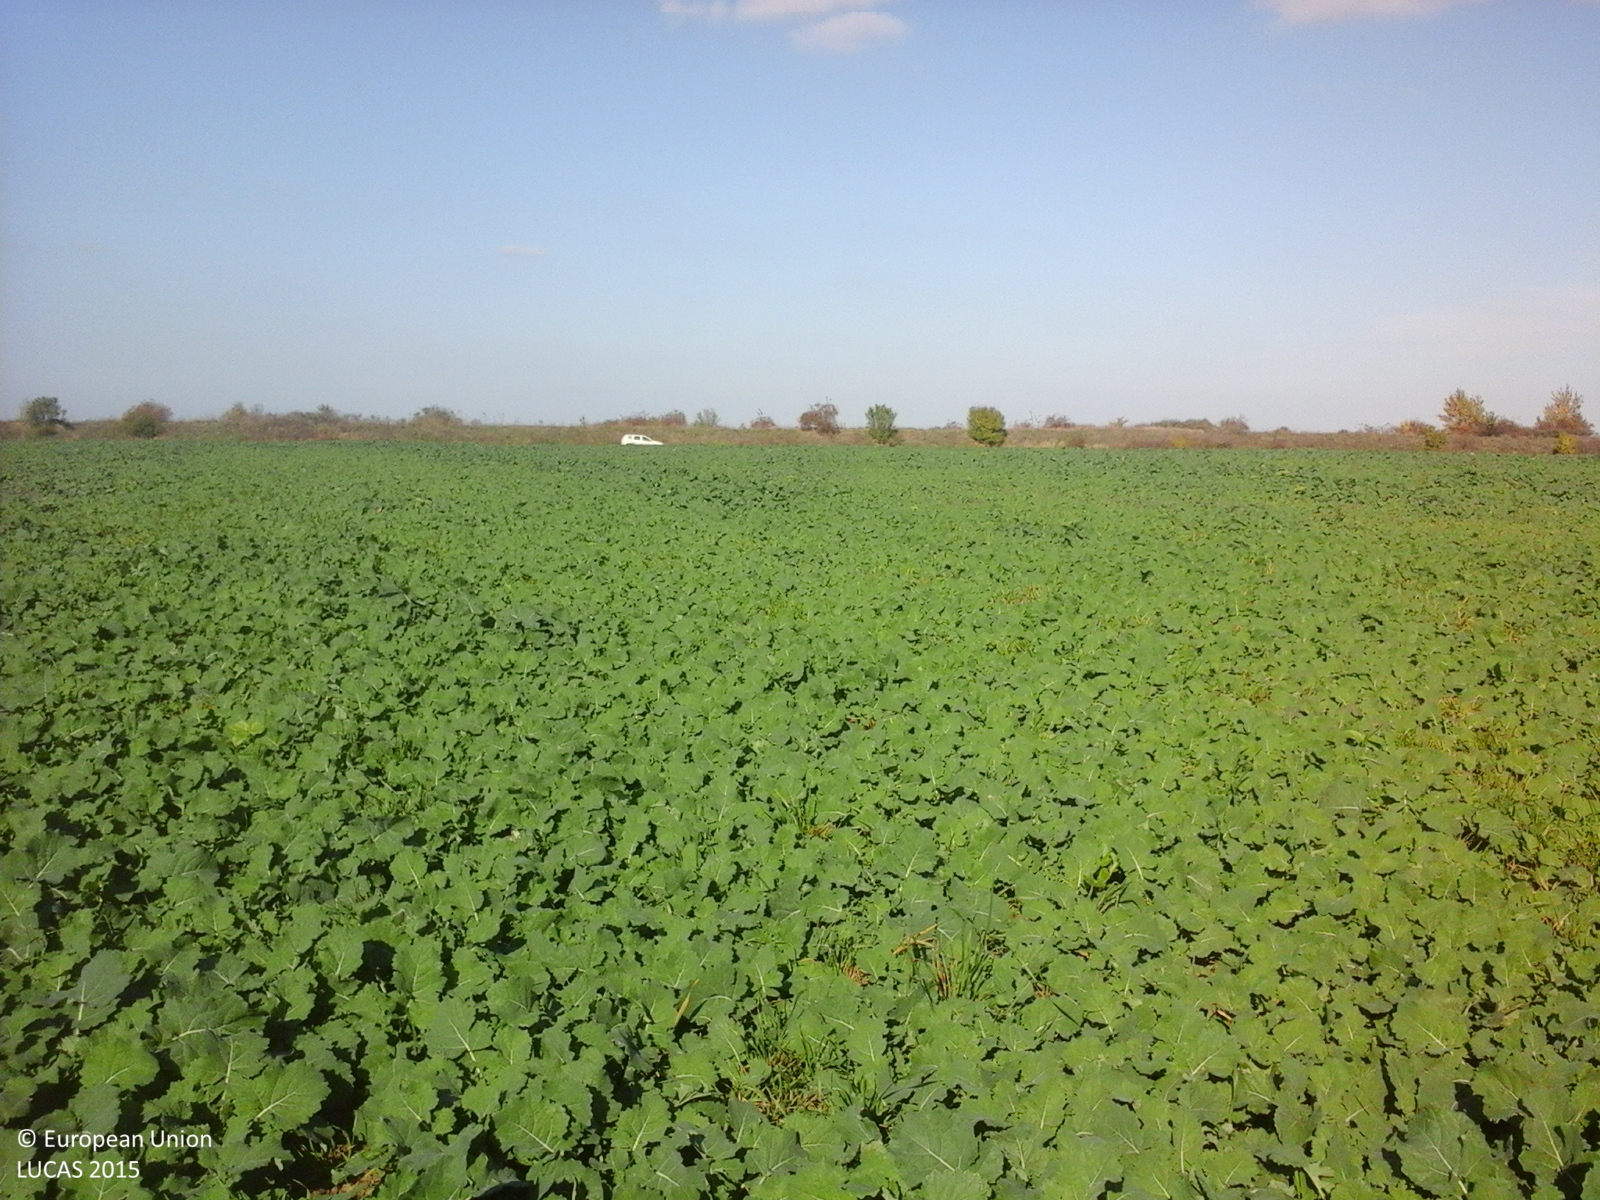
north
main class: Cropland
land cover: Rape and turnip rape
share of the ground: > 75 %
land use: Agriculture (excluding fallow land and kitchen gardens)
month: October
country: RO
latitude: 45.3104
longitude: 27.4325
